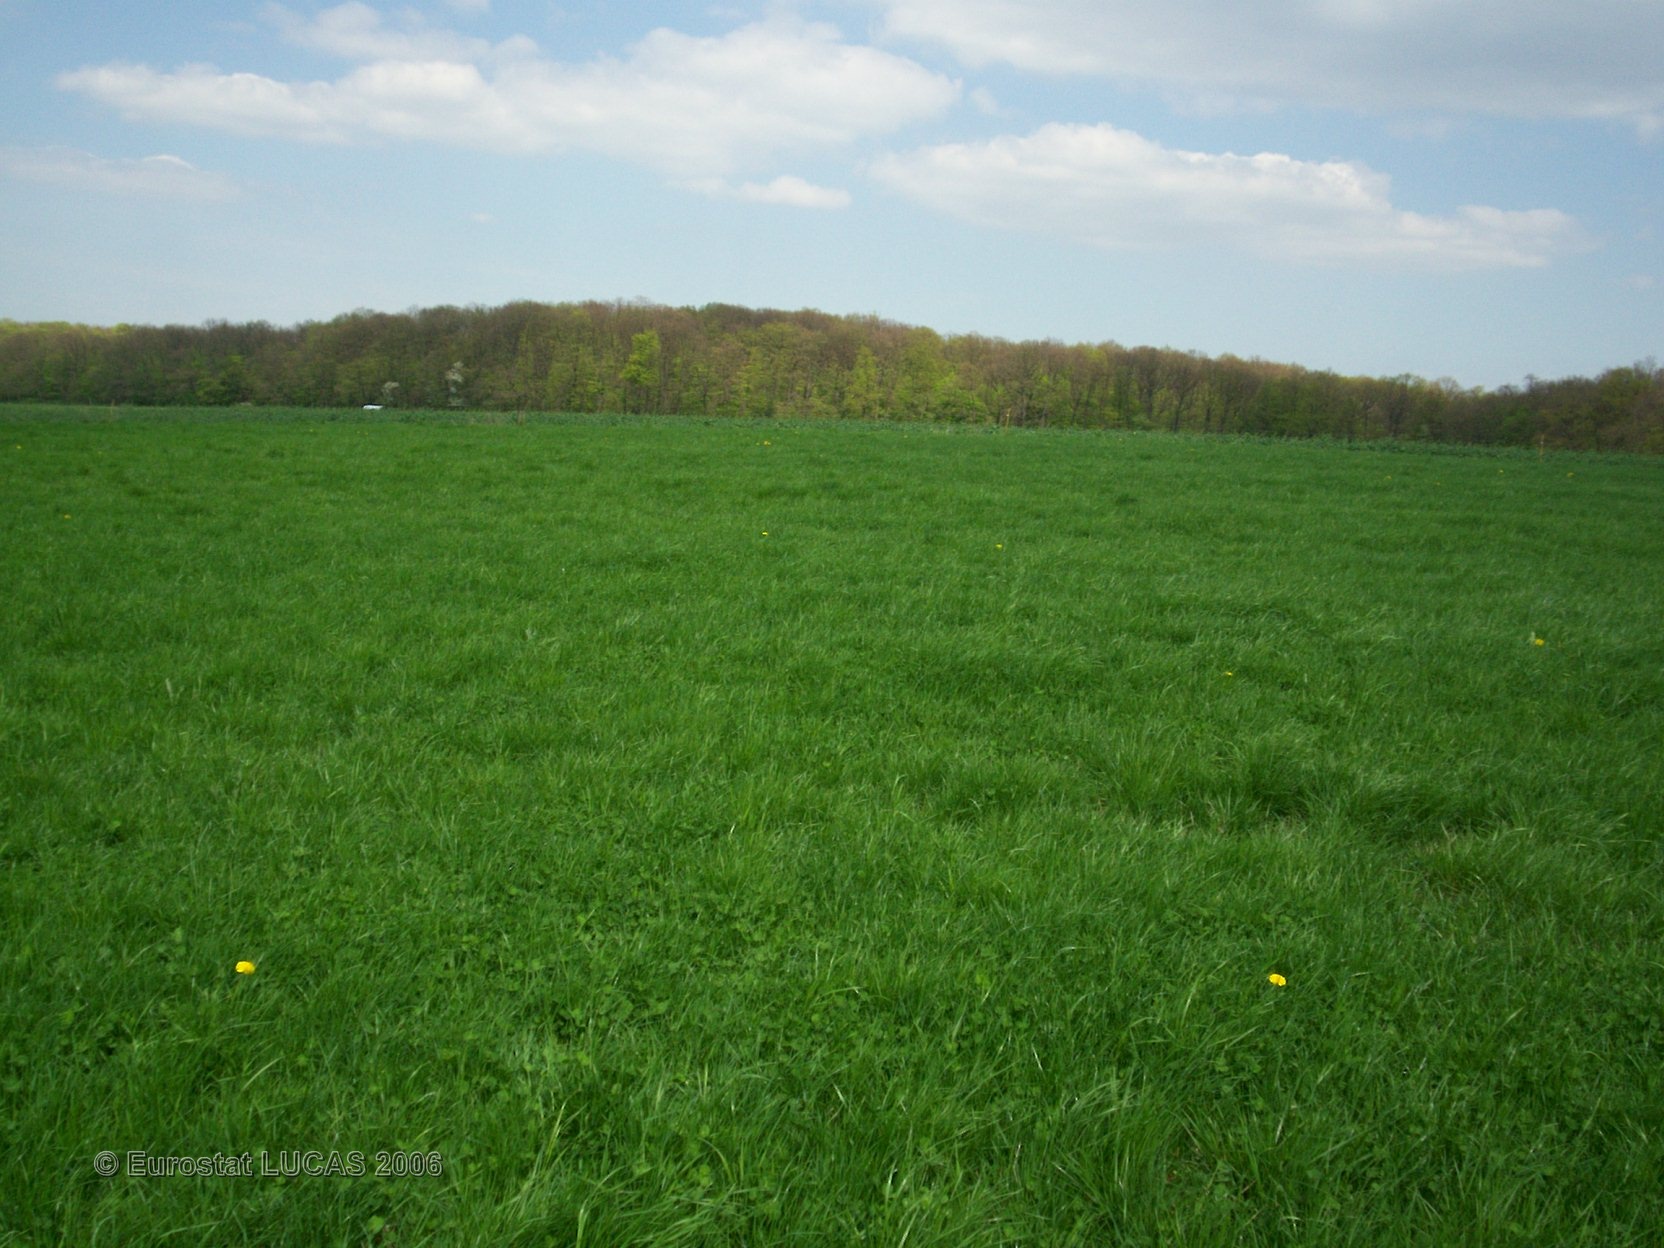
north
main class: Grassland
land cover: Grassland without tree/shrub cover
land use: Agriculture (excluding fallow land and kitchen gardens)
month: April
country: FR
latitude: 48.9863
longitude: 6.7617
